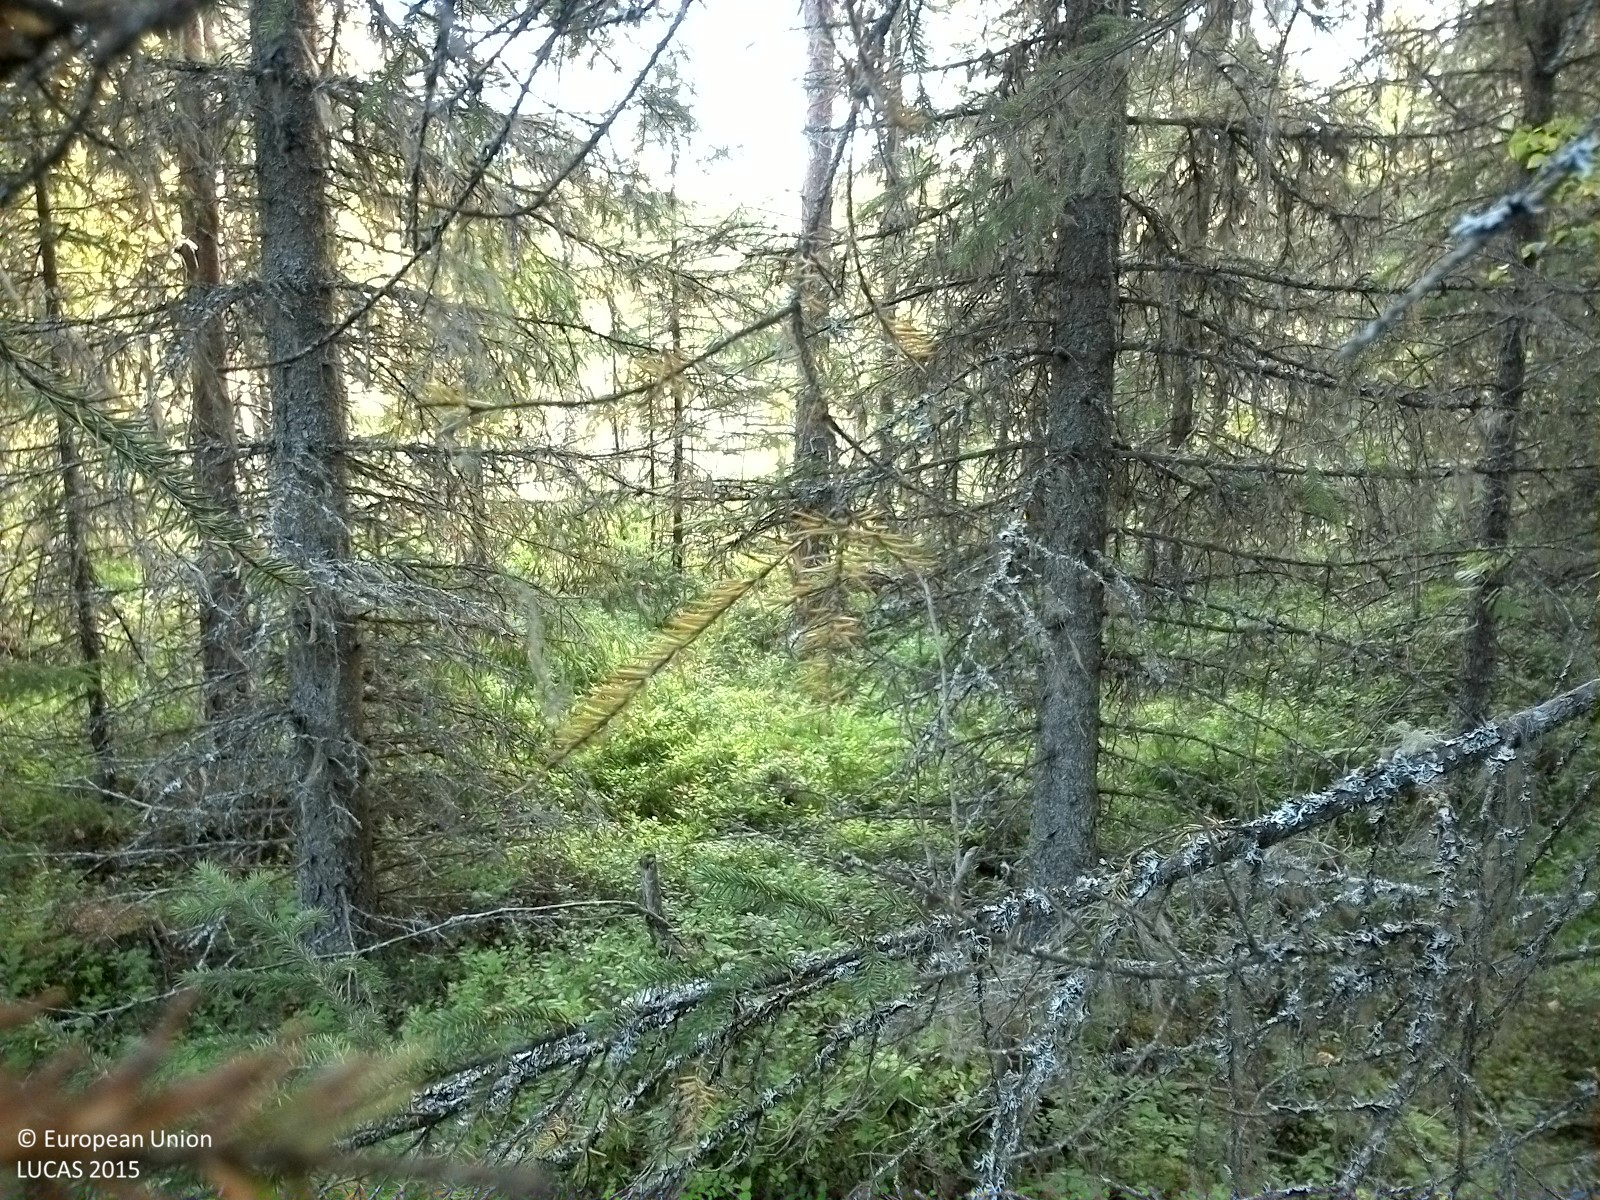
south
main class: Woodland
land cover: Spruce dominated coniferous woodland
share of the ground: > 75 %
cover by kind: coniferous forest trees 60 %, shrubs 15 %, lichens and mosses 15 %, broadleaved forest trees 10 %
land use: Forestry
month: September
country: SE
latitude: 62.6100
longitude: 16.2331
